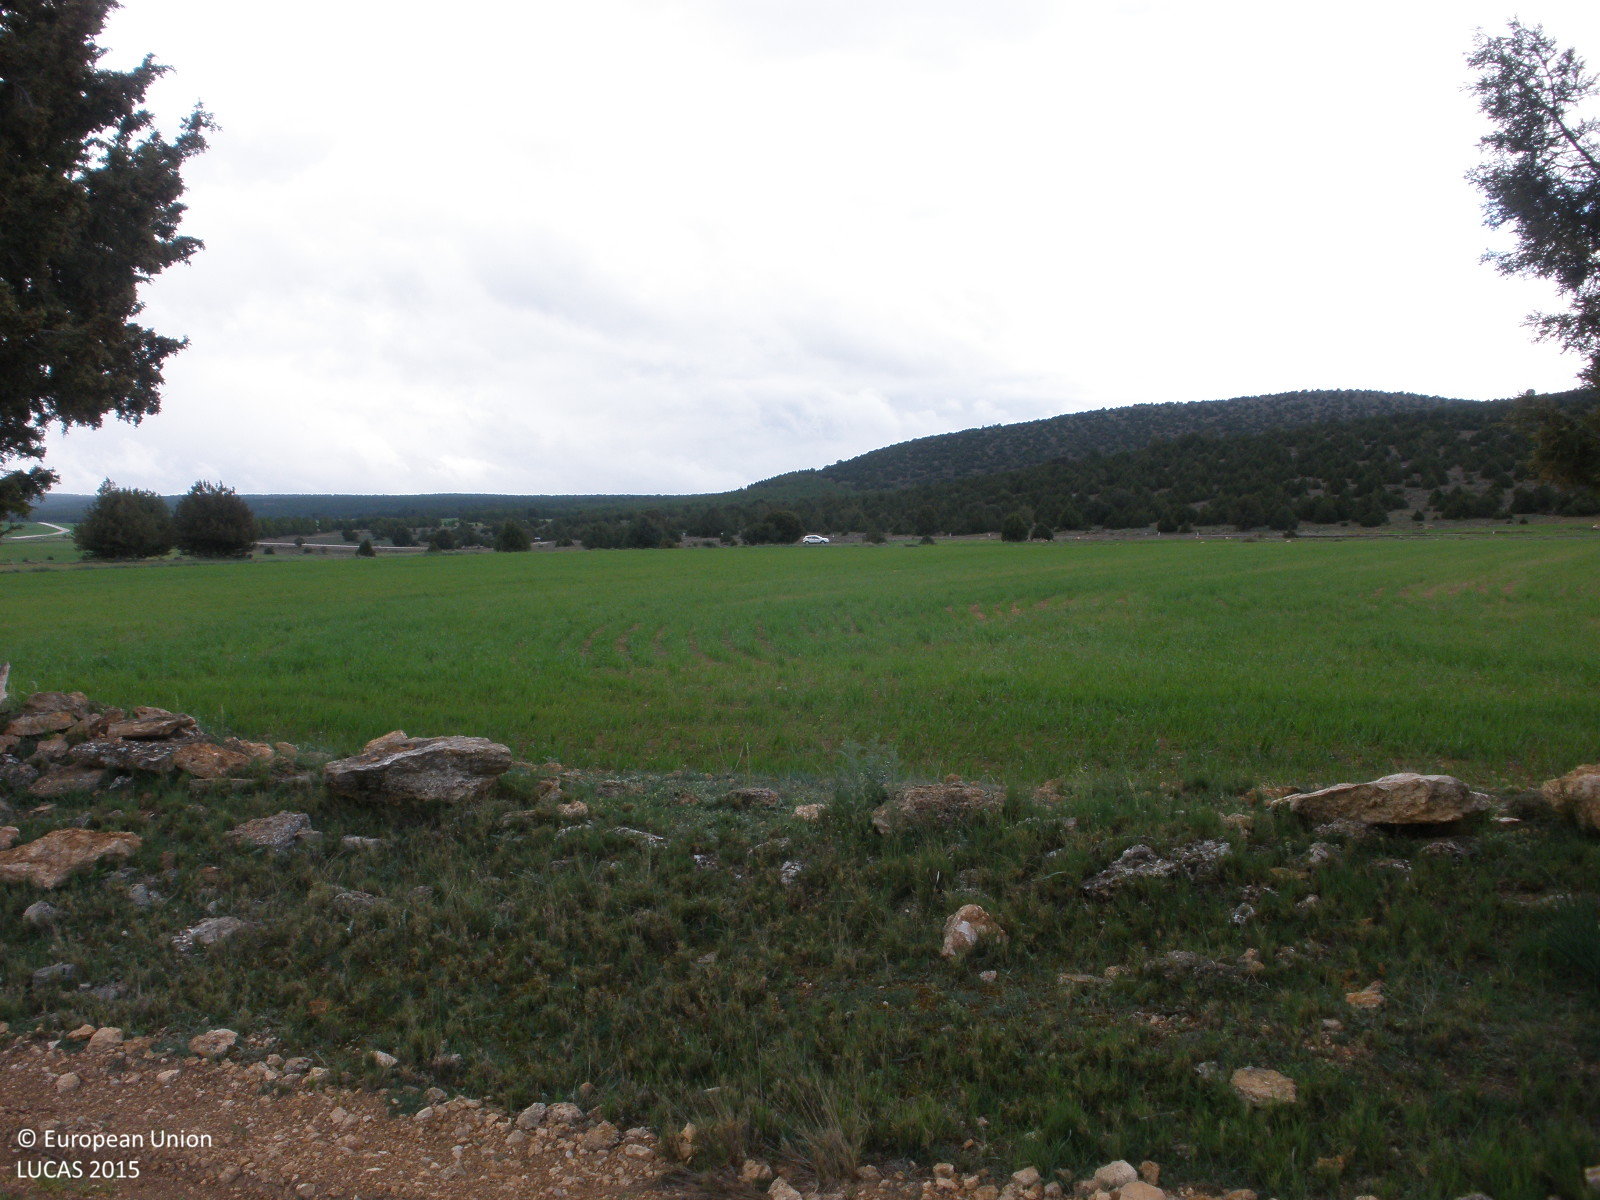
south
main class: Cropland
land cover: Barley
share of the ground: 50 - 75 %
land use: Agriculture (excluding fallow land and kitchen gardens)
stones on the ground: 25 - 50 %
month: April
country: ES
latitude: 40.3269
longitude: -1.2751
